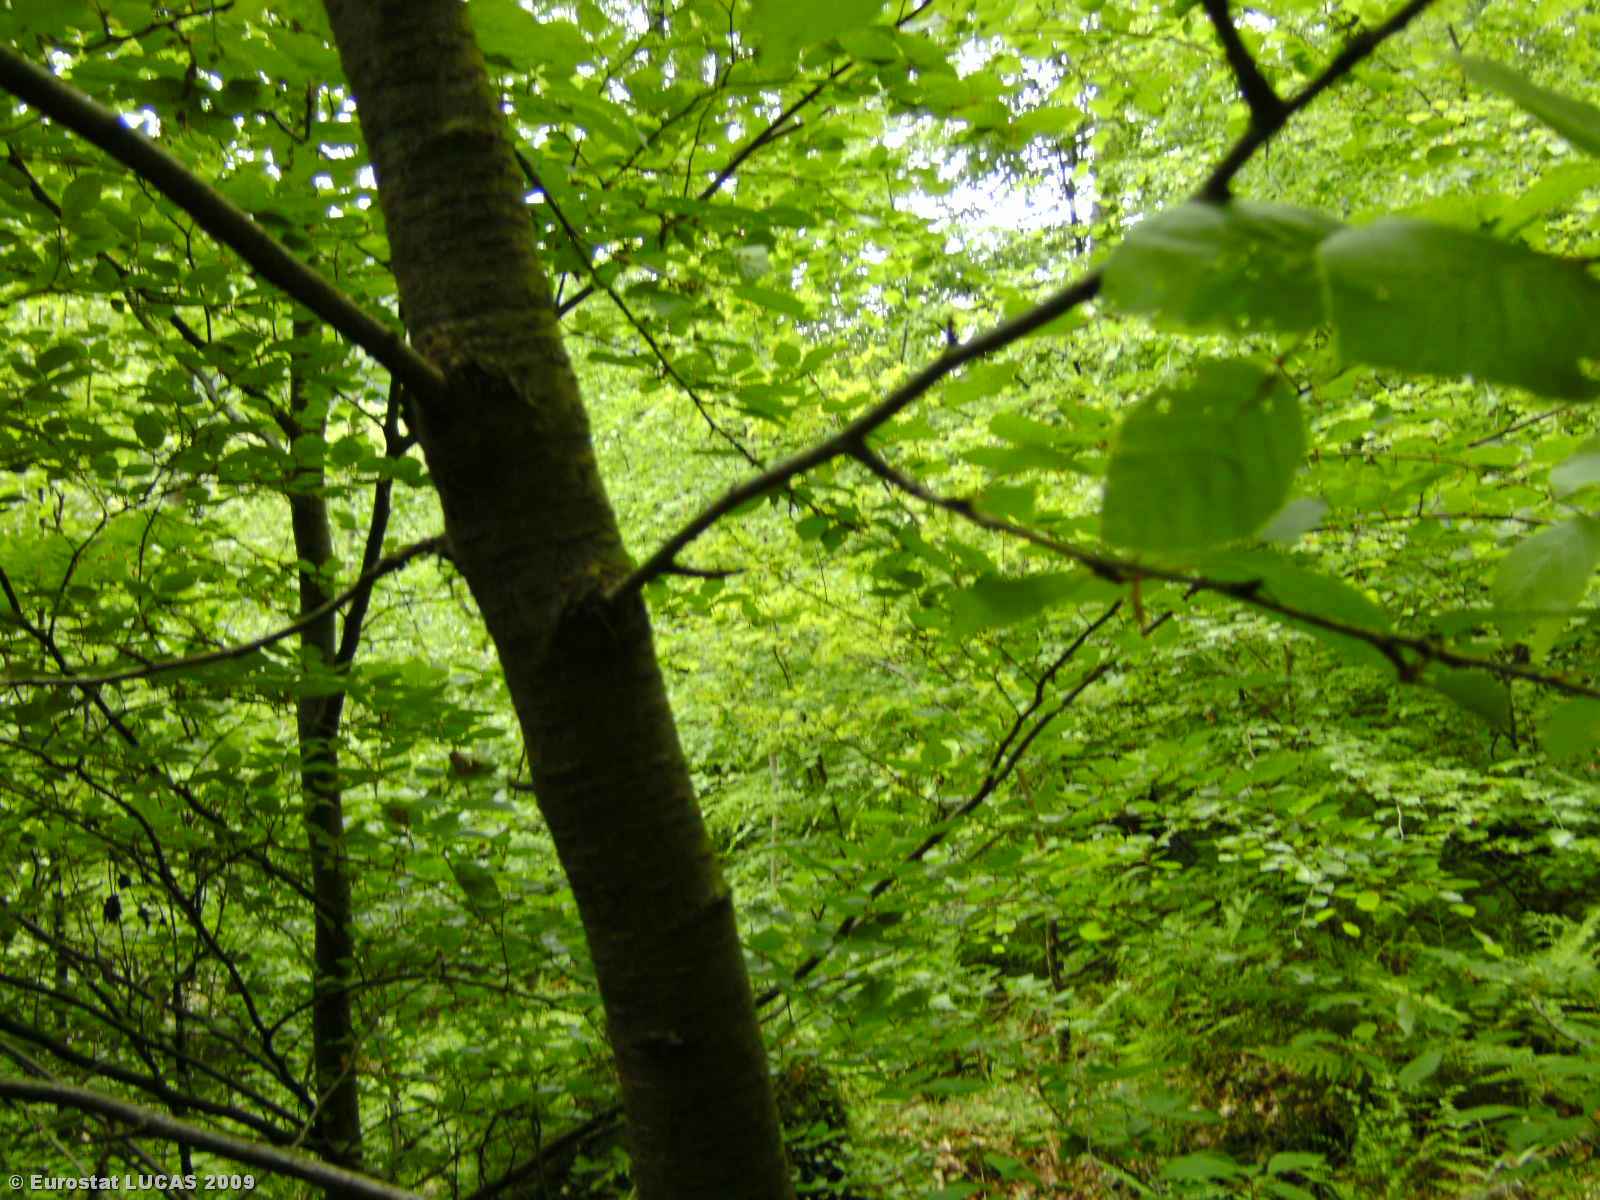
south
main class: Woodland
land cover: Broadleaved woodland
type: beech forest
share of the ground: > 75 %
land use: Forestry
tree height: > 5 m
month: May
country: LU
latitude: 49.7404
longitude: 6.1279
